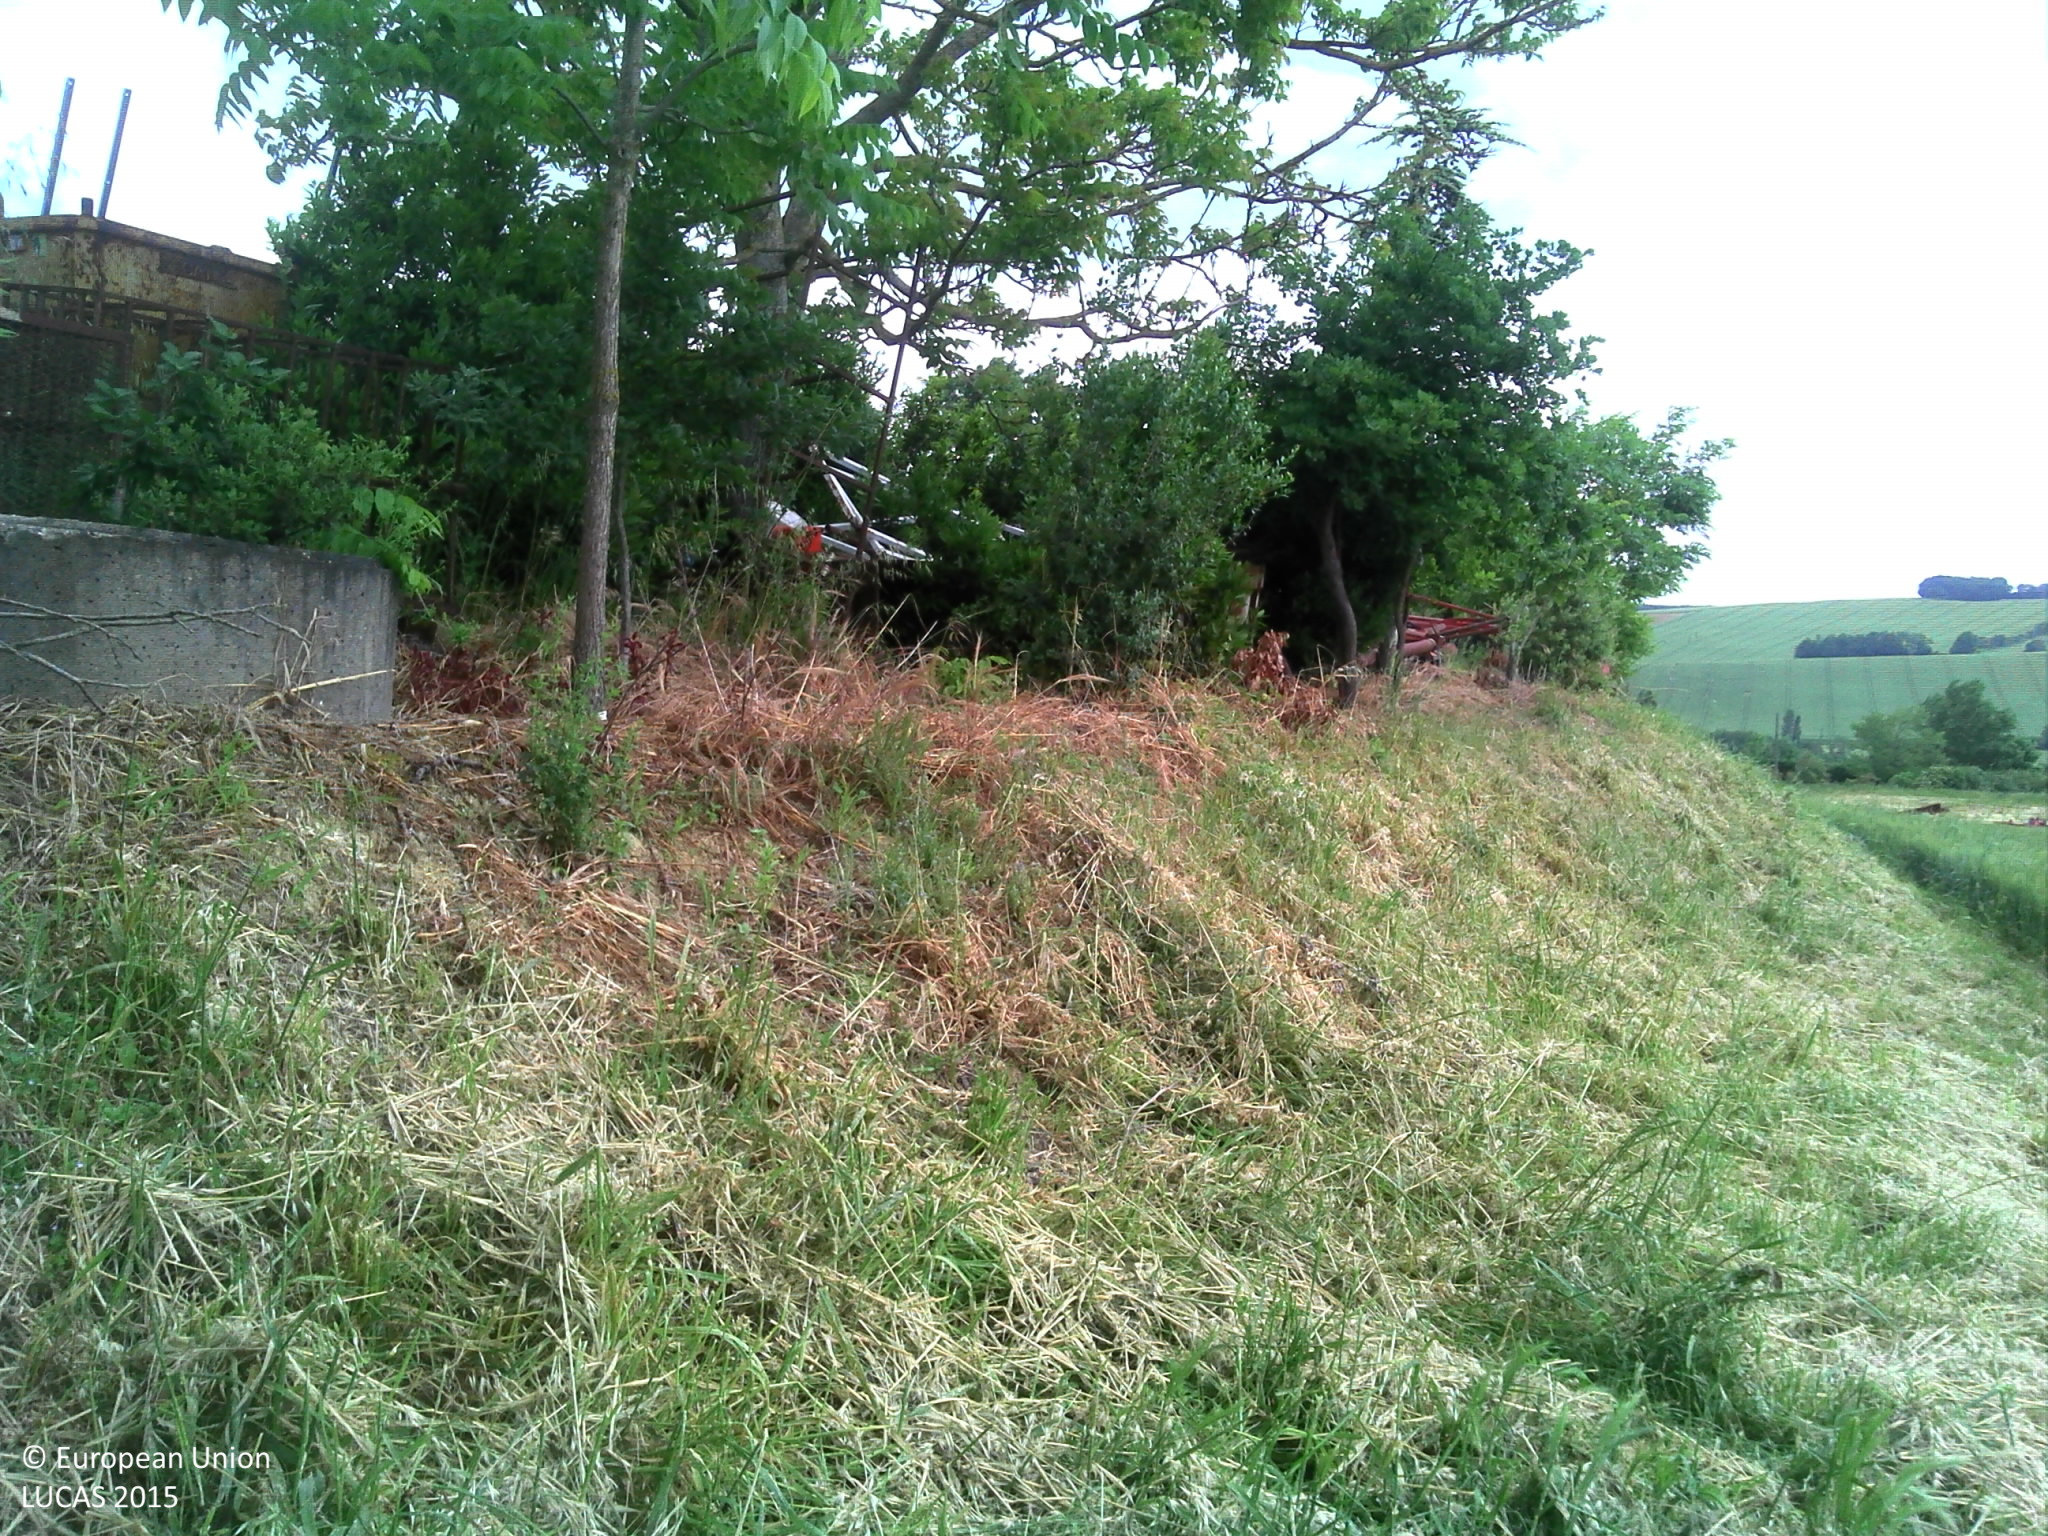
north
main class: Grassland
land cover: Grassland with sparse tree/shrub cover
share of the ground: > 75 %
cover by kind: herbaceous plants 95 %, broadleaved forest trees 5 %
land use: Agriculture (excluding fallow land and kitchen gardens)
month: May
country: FR
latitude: 43.7115
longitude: 1.7252
